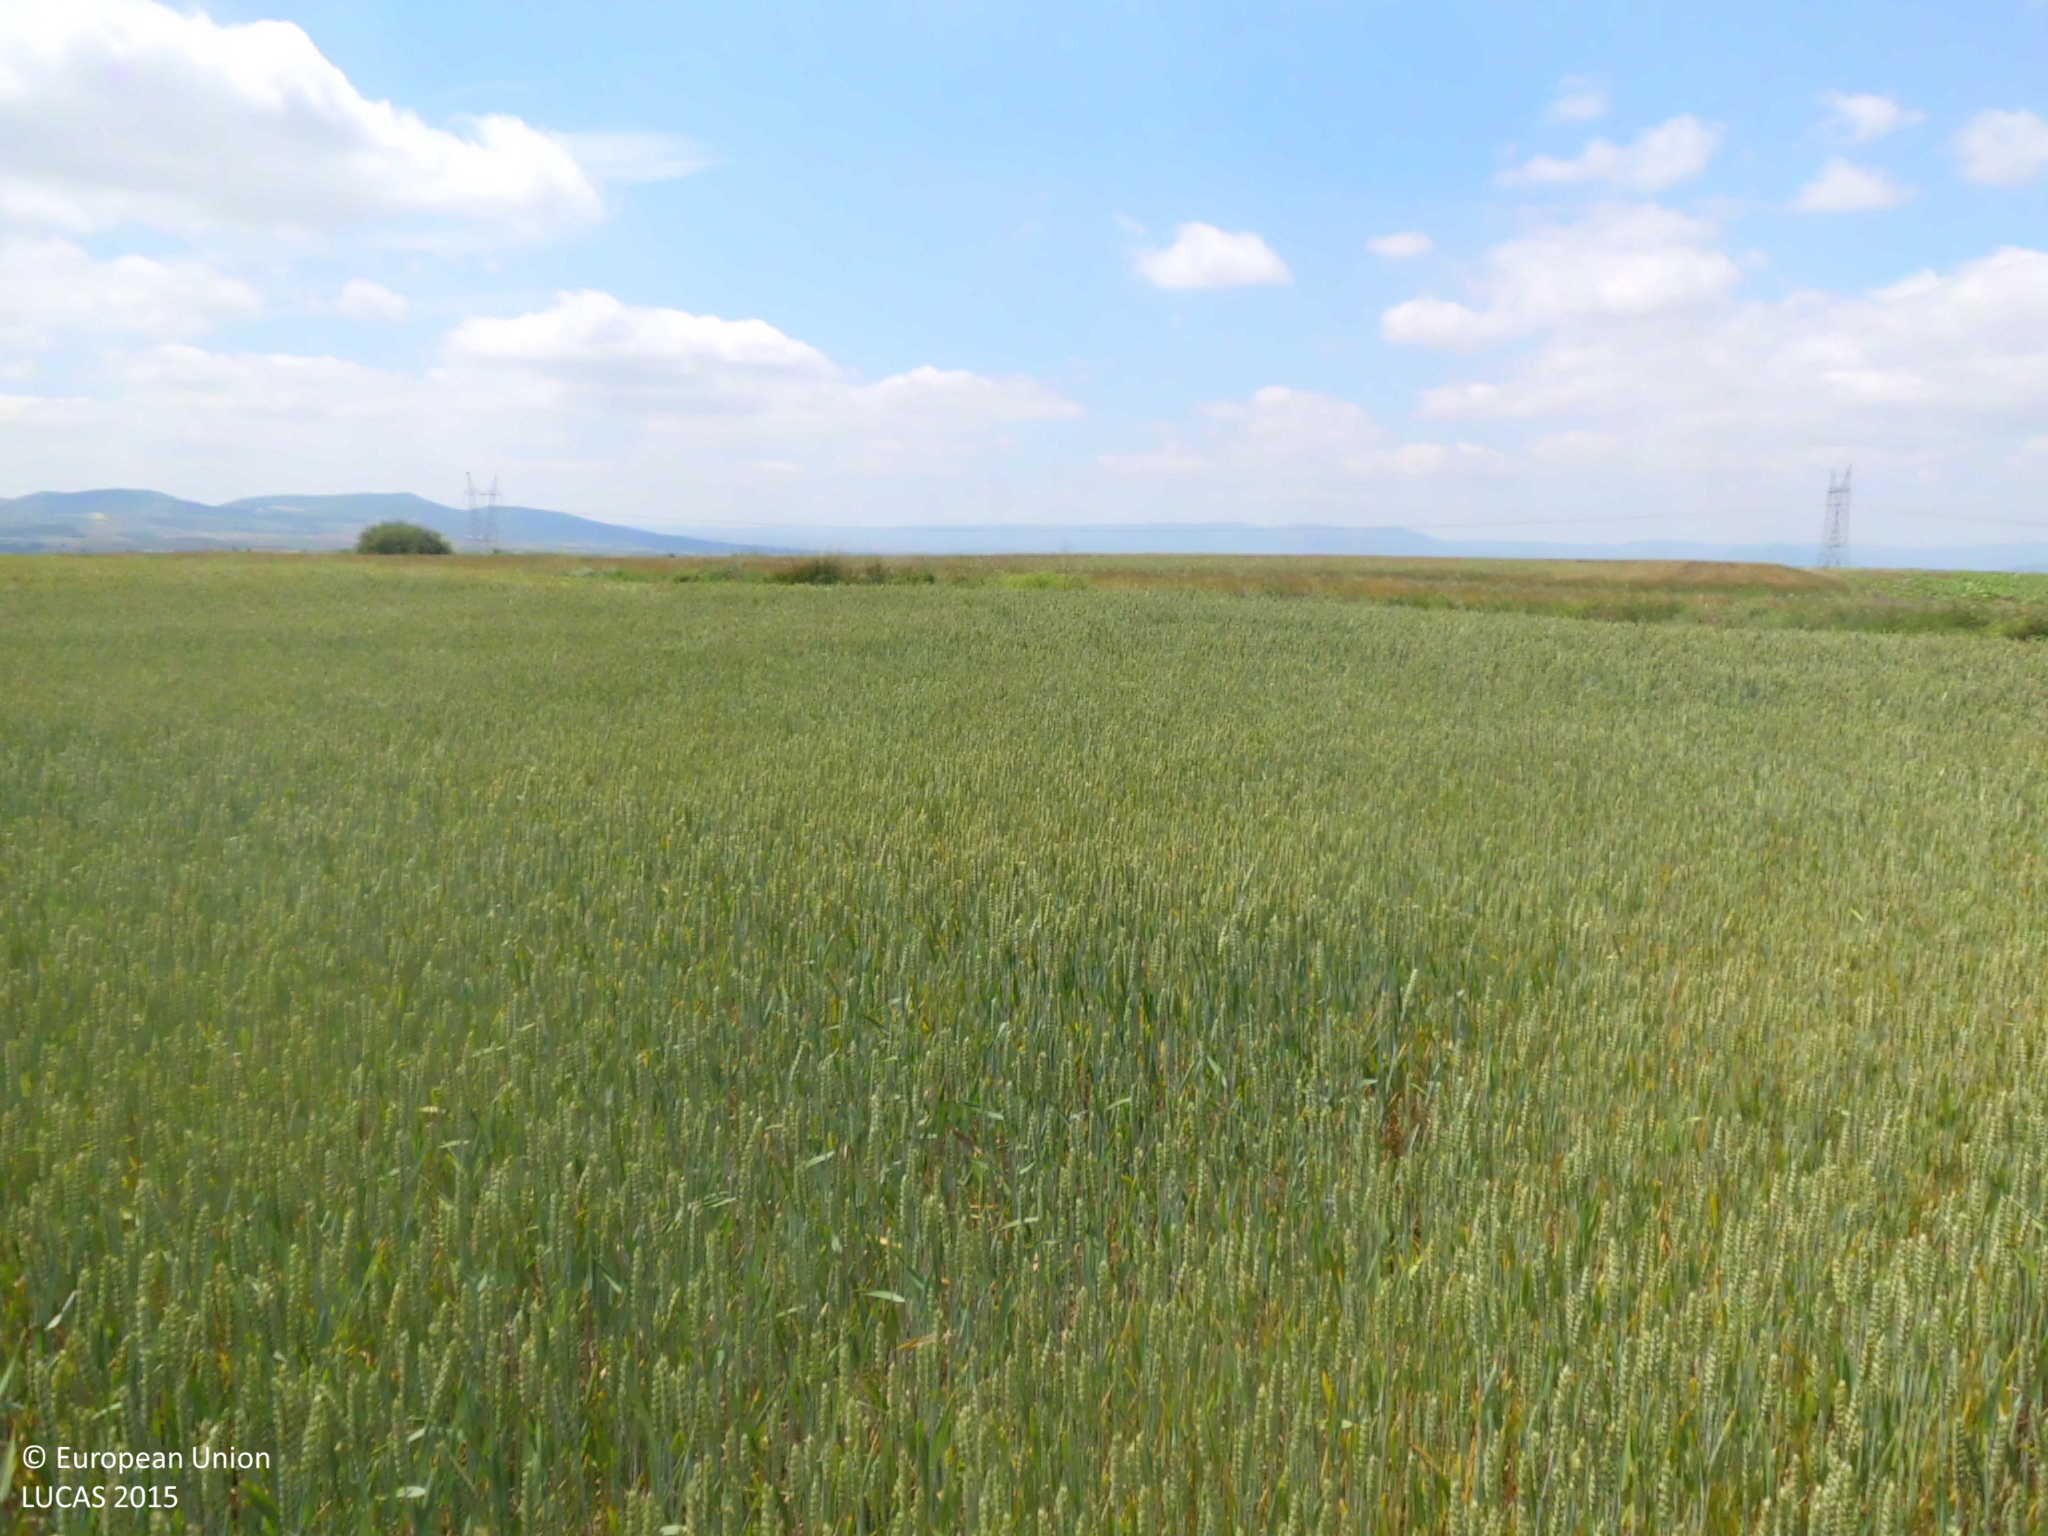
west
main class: Cropland
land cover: Common wheat
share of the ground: > 75 %
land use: Agriculture (excluding fallow land and kitchen gardens)
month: June
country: ES
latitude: 42.5799
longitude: -3.2765
